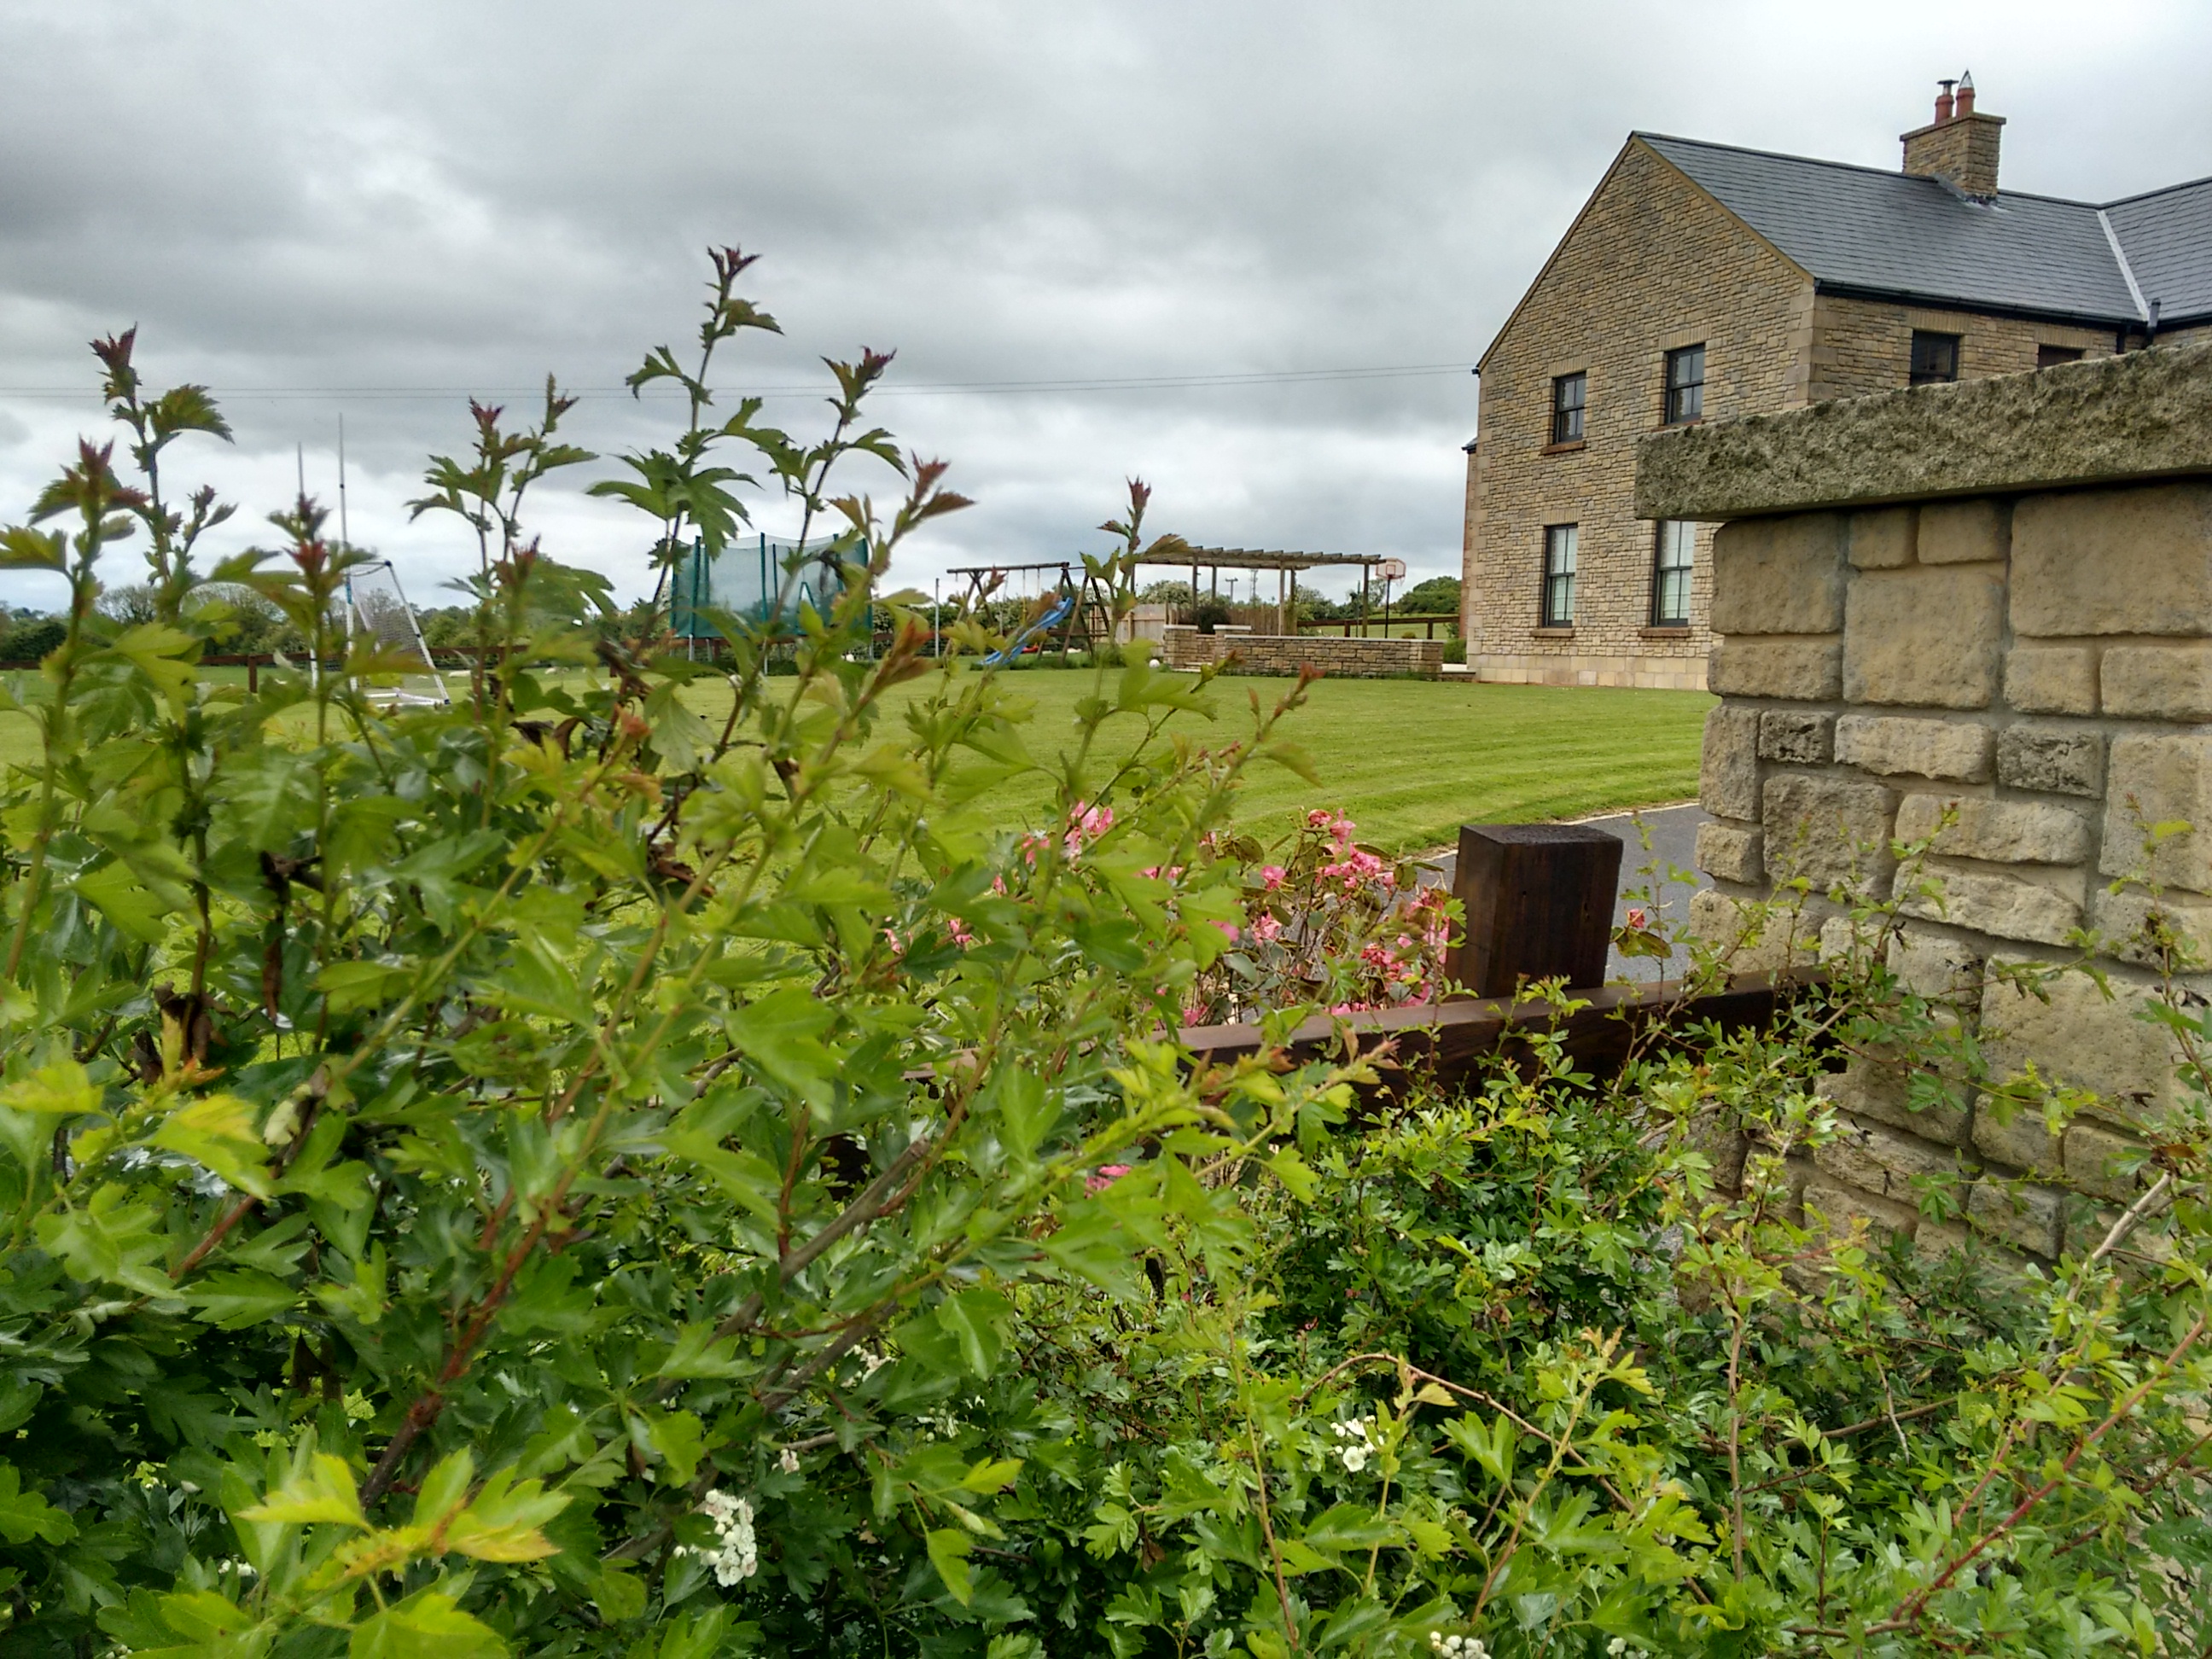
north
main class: Grassland
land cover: Grassland without tree/shrub cover
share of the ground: > 75 %
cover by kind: herbaceous plants 100 %
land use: Residential
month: May
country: IE
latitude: 53.4723
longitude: -6.6273
